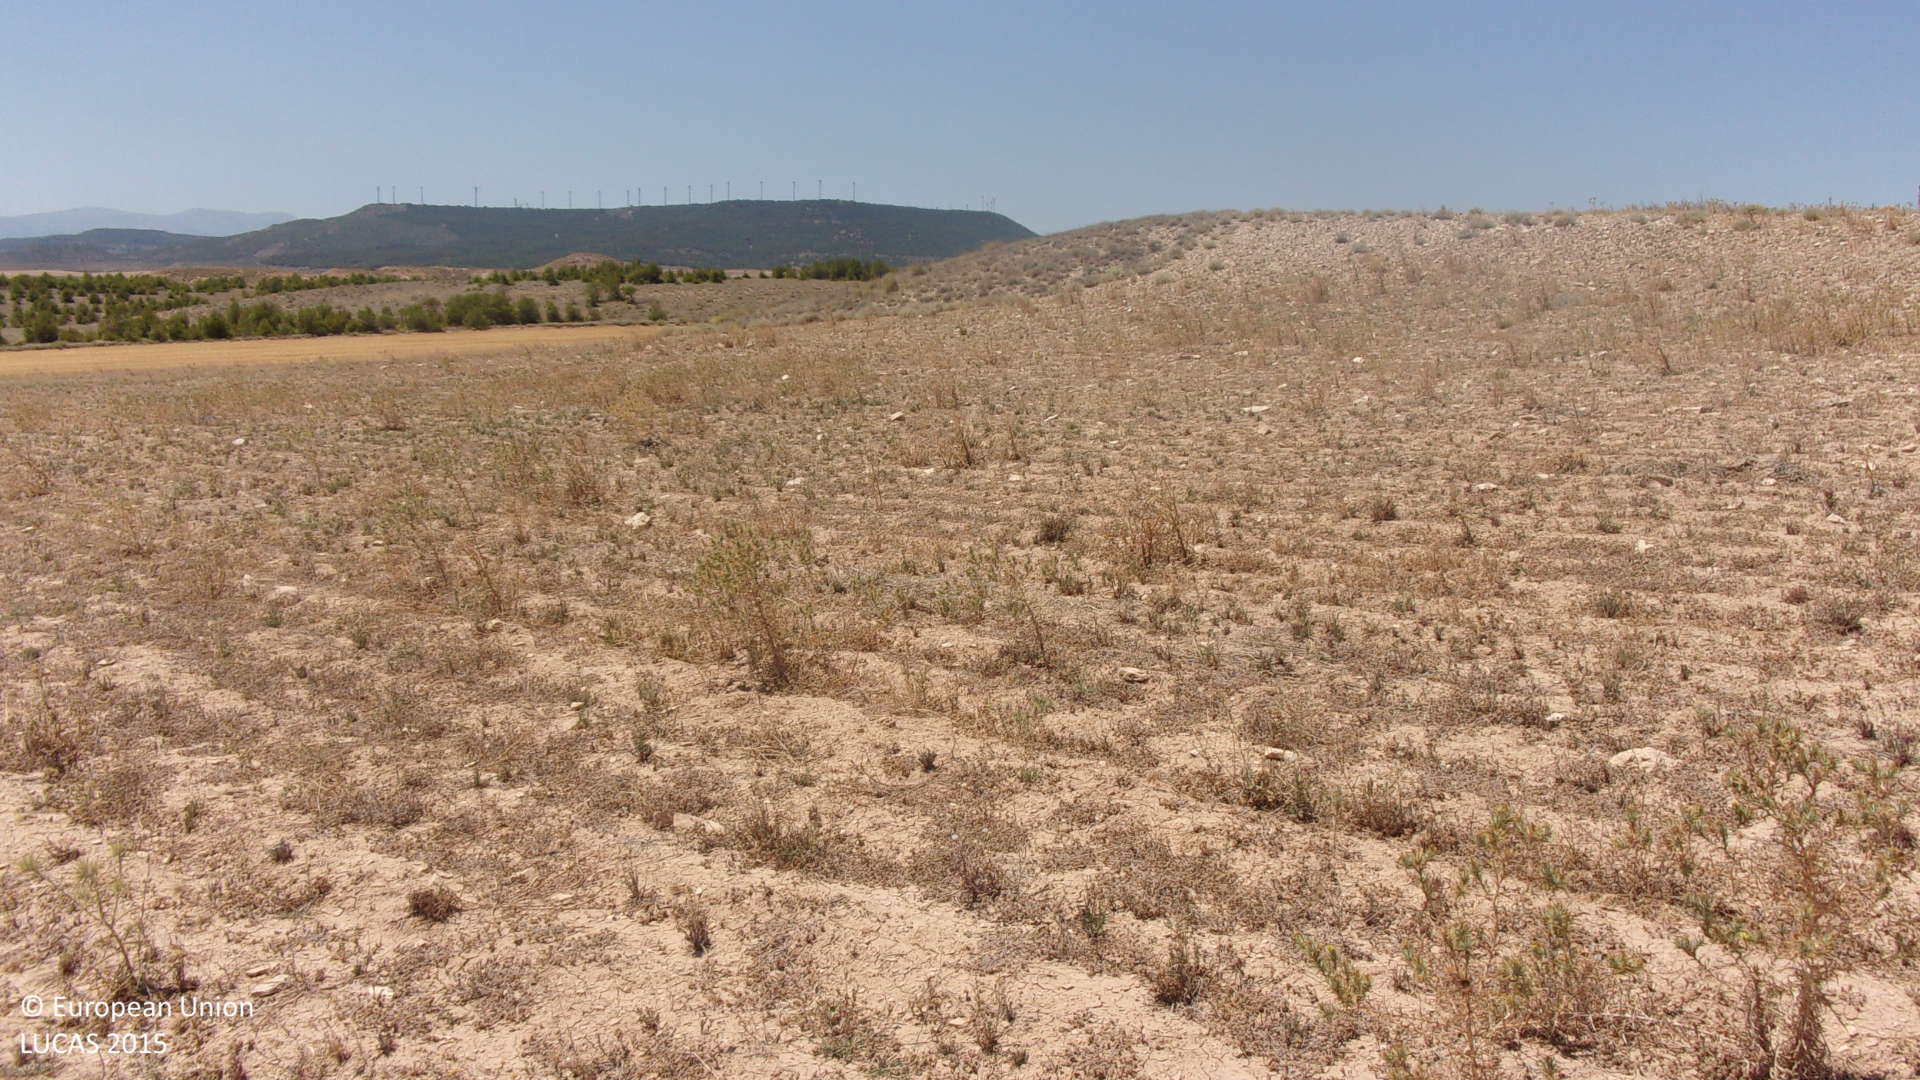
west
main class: Grassland
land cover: Spontaneously vegetated surfaces
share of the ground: 25 - 50 %
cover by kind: unconsolidated bare surface 65 %, herbaceous plants 35 %
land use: Fallow land
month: July
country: ES
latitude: 41.8885
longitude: -1.4904
